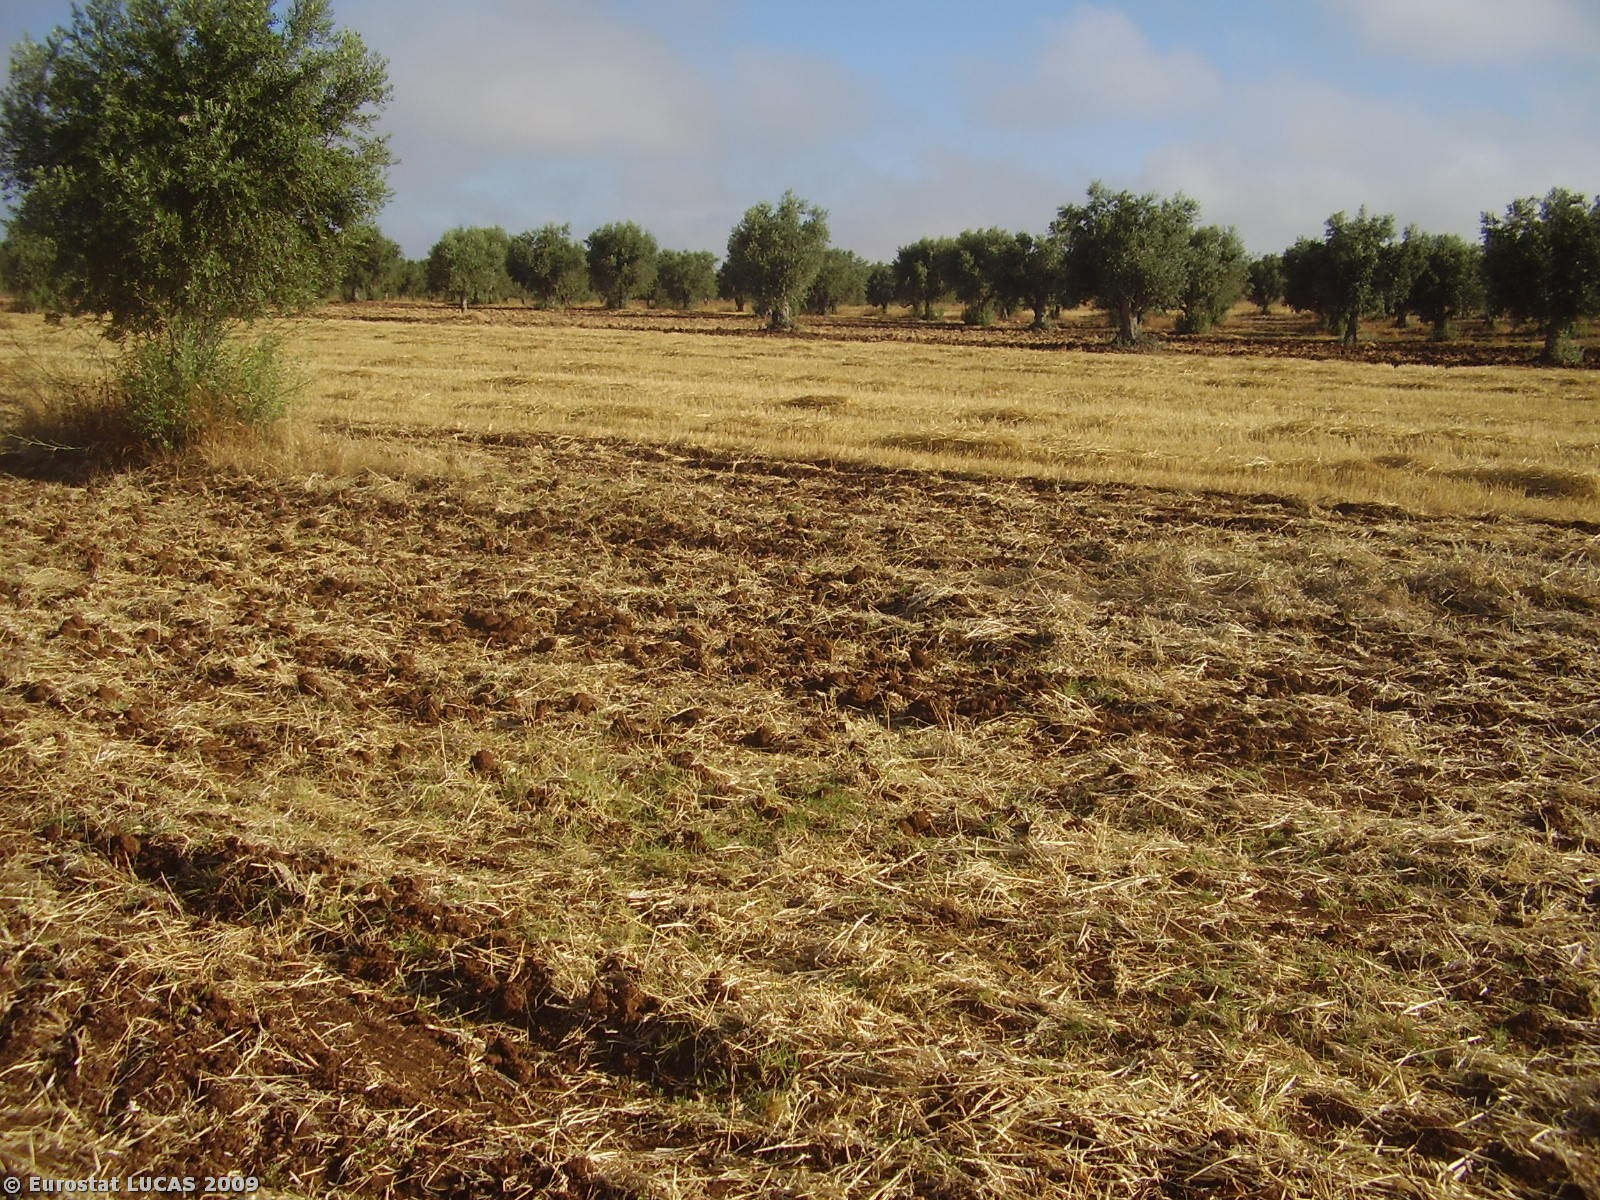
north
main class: Cropland
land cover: Olive groves
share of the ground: 10 - 25 %
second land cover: Oats
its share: > 75 %
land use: Agriculture (excluding fallow land and kitchen gardens)
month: August
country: PT
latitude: 38.0762
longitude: -7.9631
